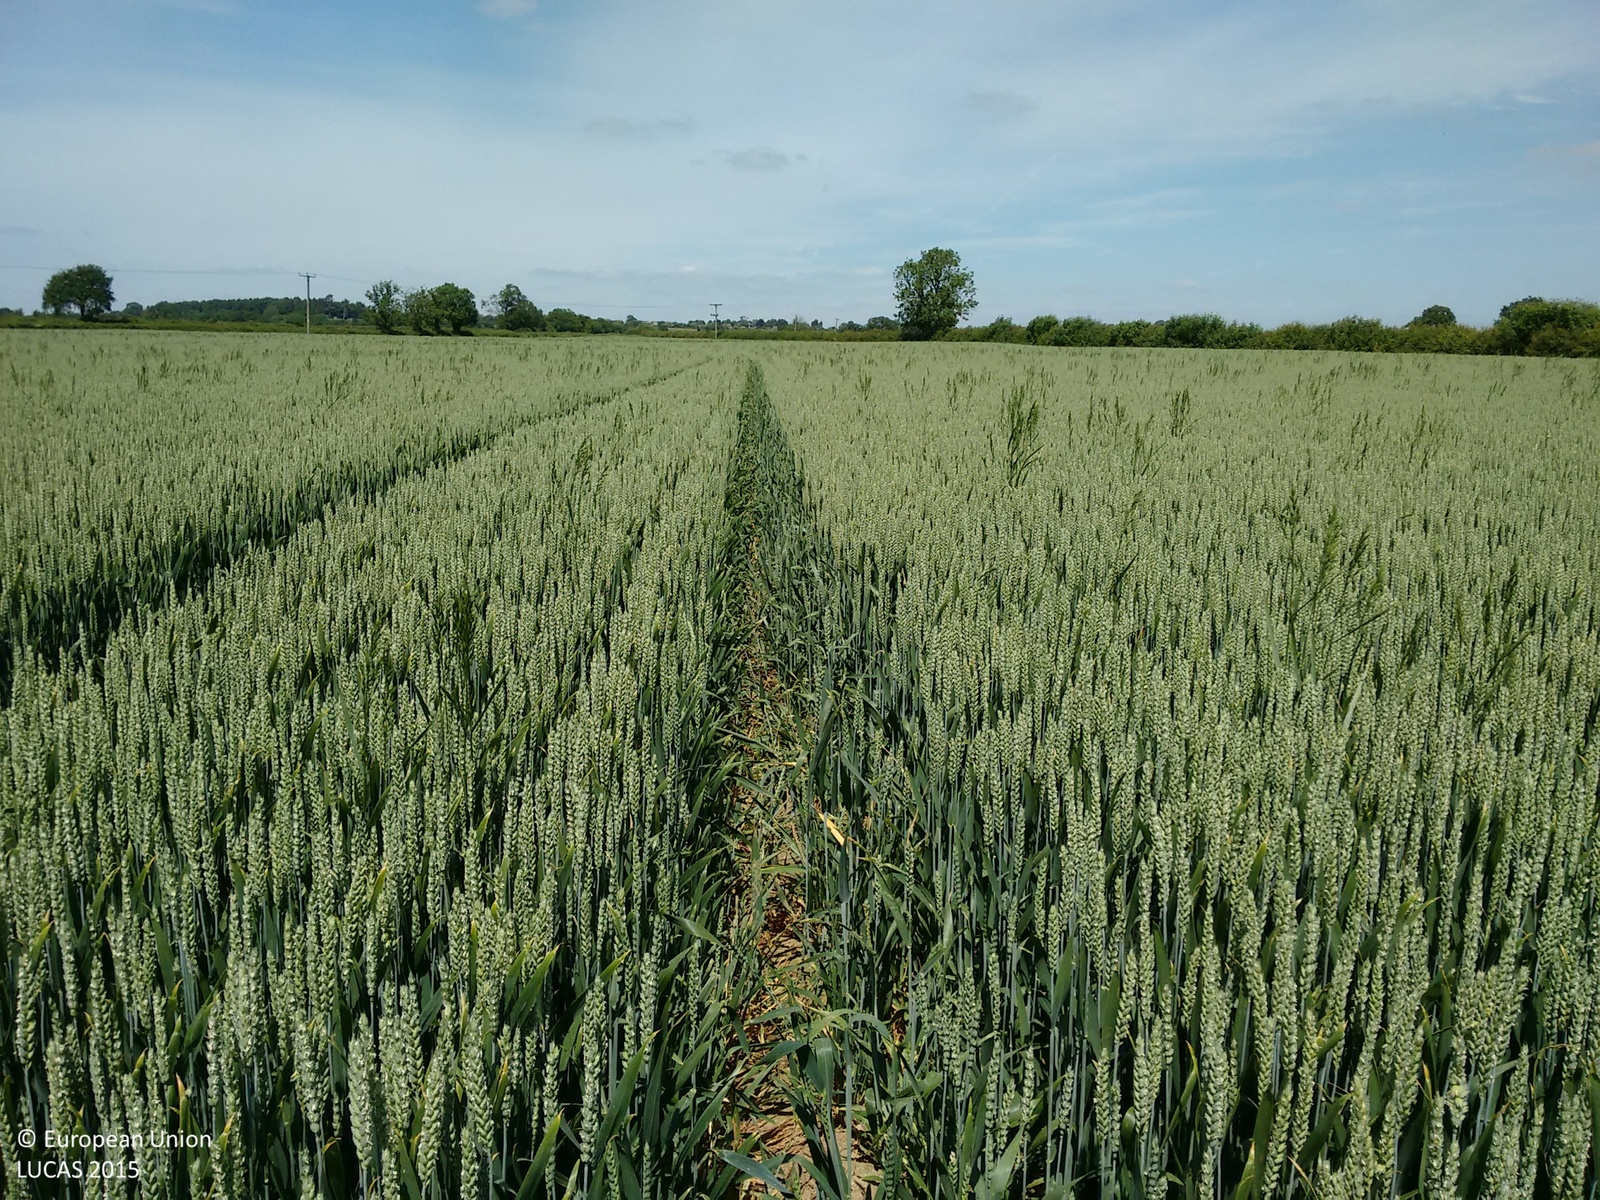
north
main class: Cropland
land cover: Common wheat
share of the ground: > 75 %
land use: Agriculture (excluding fallow land and kitchen gardens)
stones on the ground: < 10 %
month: June
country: GB
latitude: 51.8391
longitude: -1.2671
